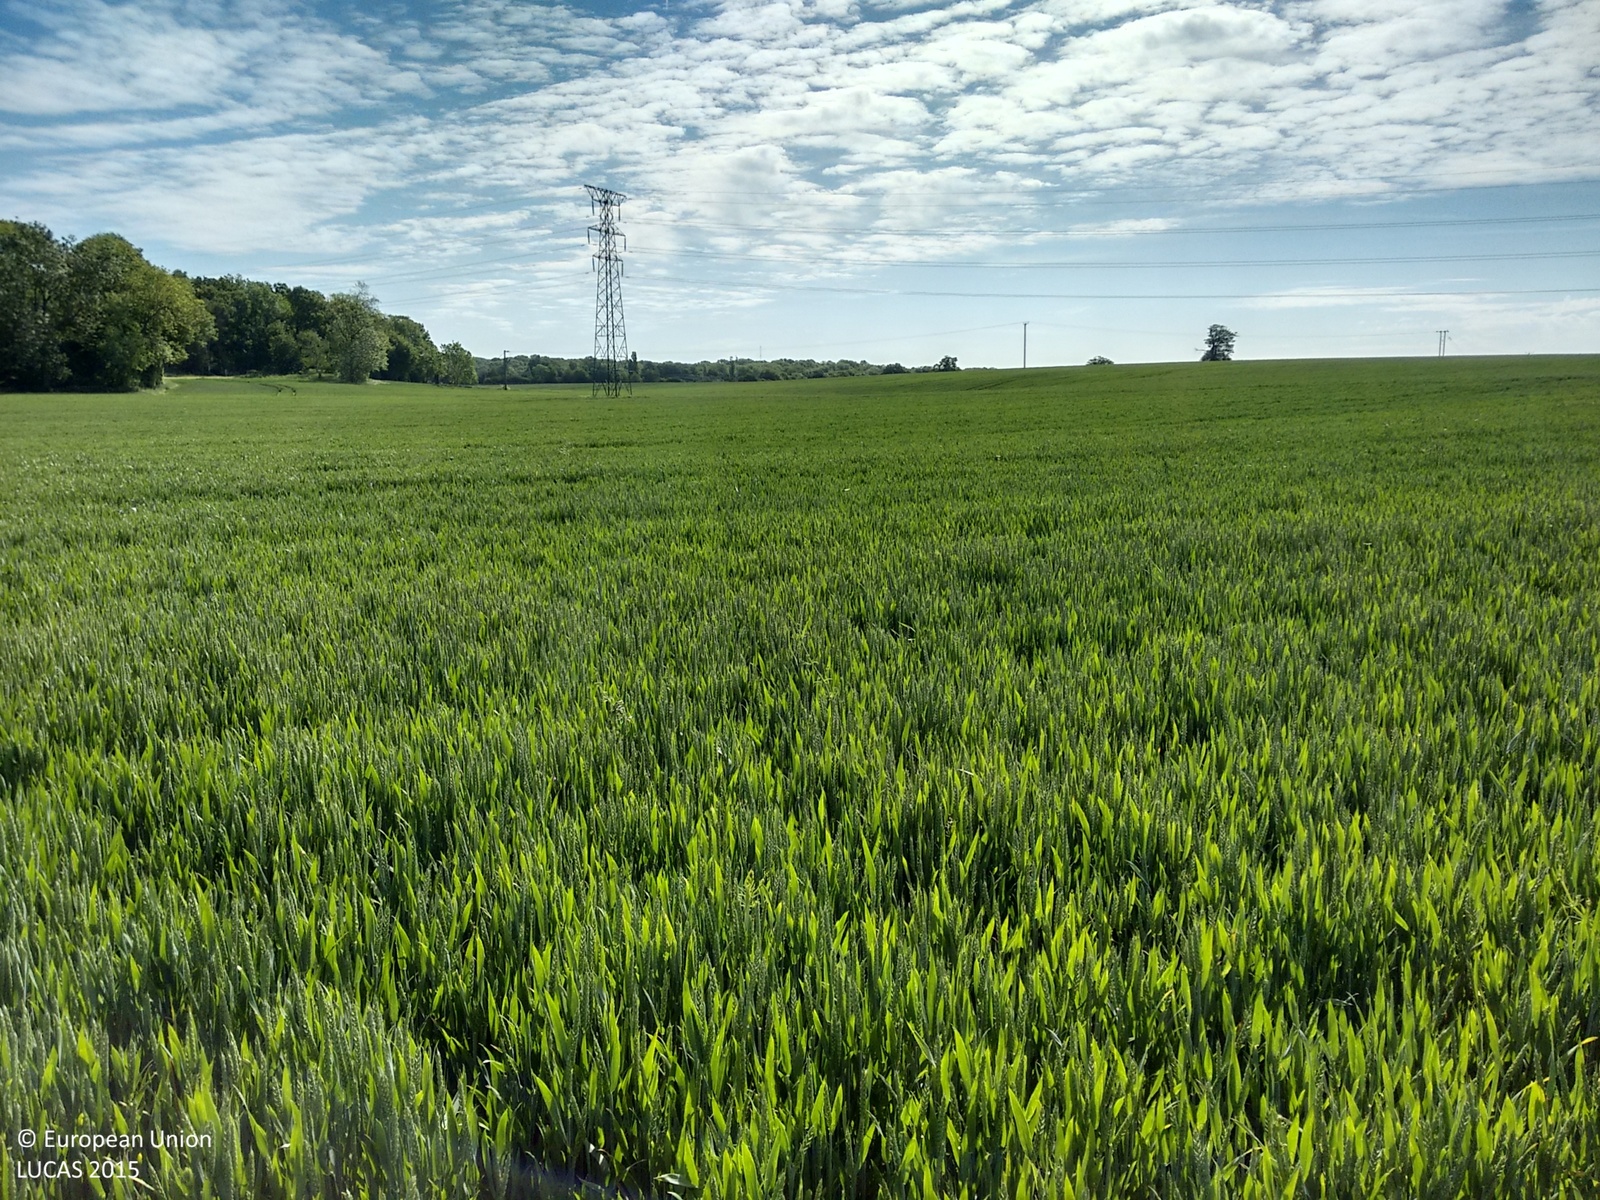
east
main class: Cropland
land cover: Common wheat
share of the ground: > 75 %
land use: Agriculture (excluding fallow land and kitchen gardens)
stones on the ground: < 10 %
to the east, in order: Common wheat; Tracks; Common wheat; Electric lines; Common wheat
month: June
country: GB
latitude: 51.7338
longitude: -0.2438
